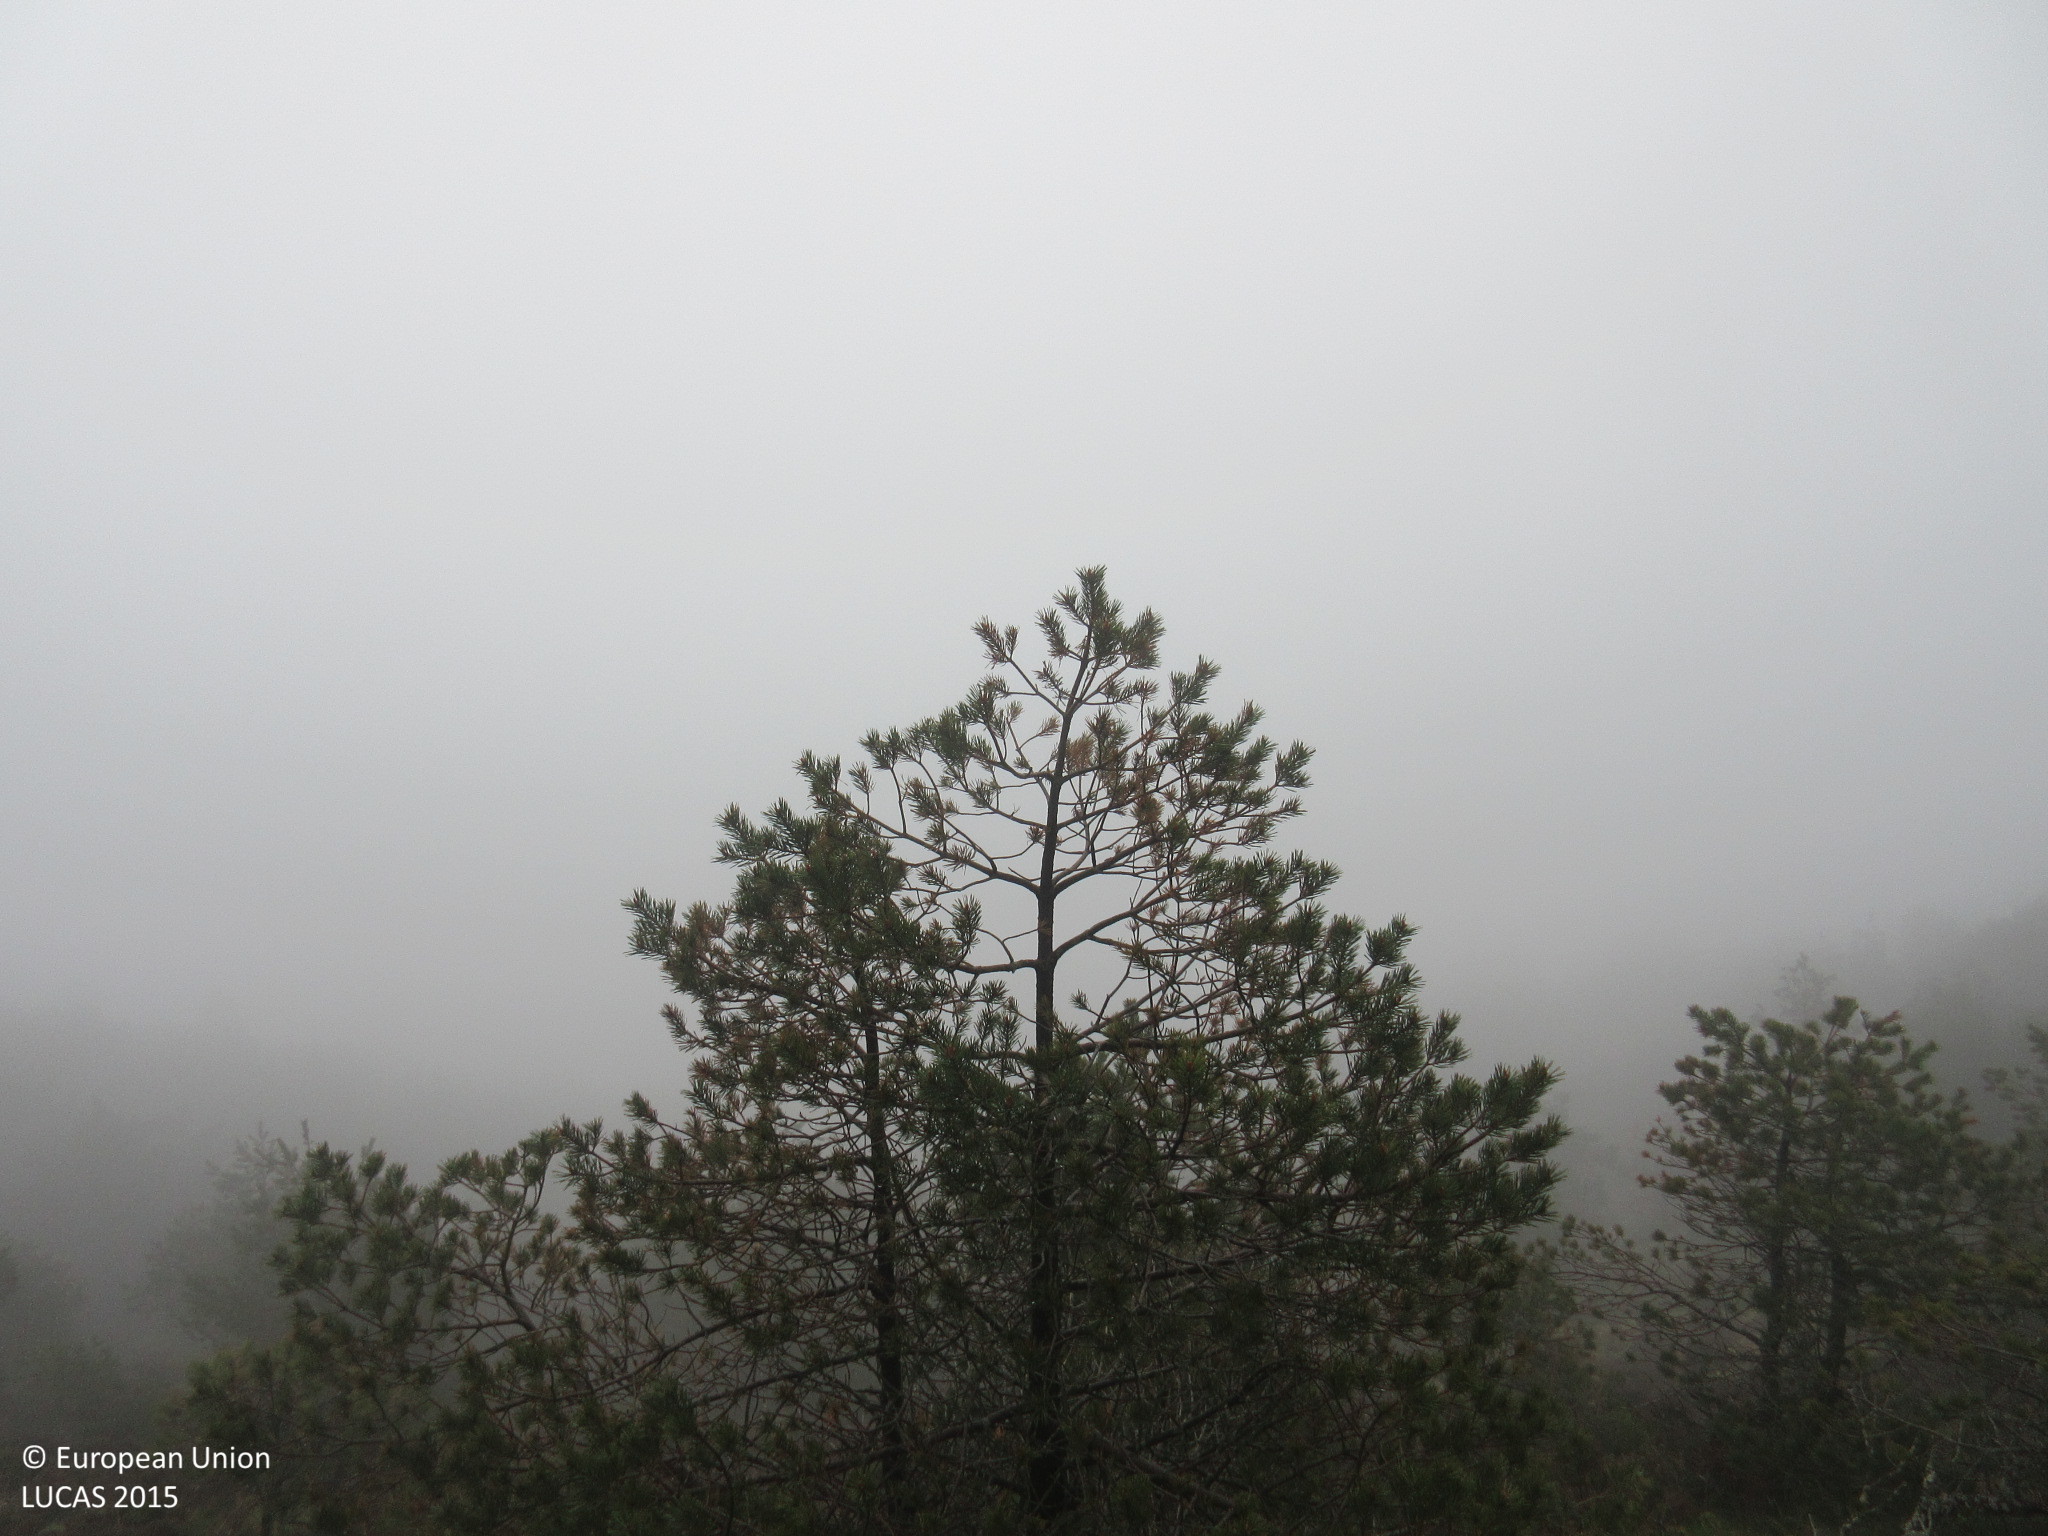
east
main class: Woodland
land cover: Pine dominated coniferous woodland
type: exotic forest
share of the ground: > 75 %
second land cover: Shrubland without tree cover
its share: > 75 %
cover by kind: coniferous forest trees 85 %, shrubs 15 %
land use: Forestry
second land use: Agriculture (excluding fallow land and kitchen gardens)
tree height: < 5 m
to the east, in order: Pine dominated coniferous woodland; Shrubland without tree cover; Pine dominated coniferous woodland
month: April
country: ES
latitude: 43.3695
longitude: -6.9348
